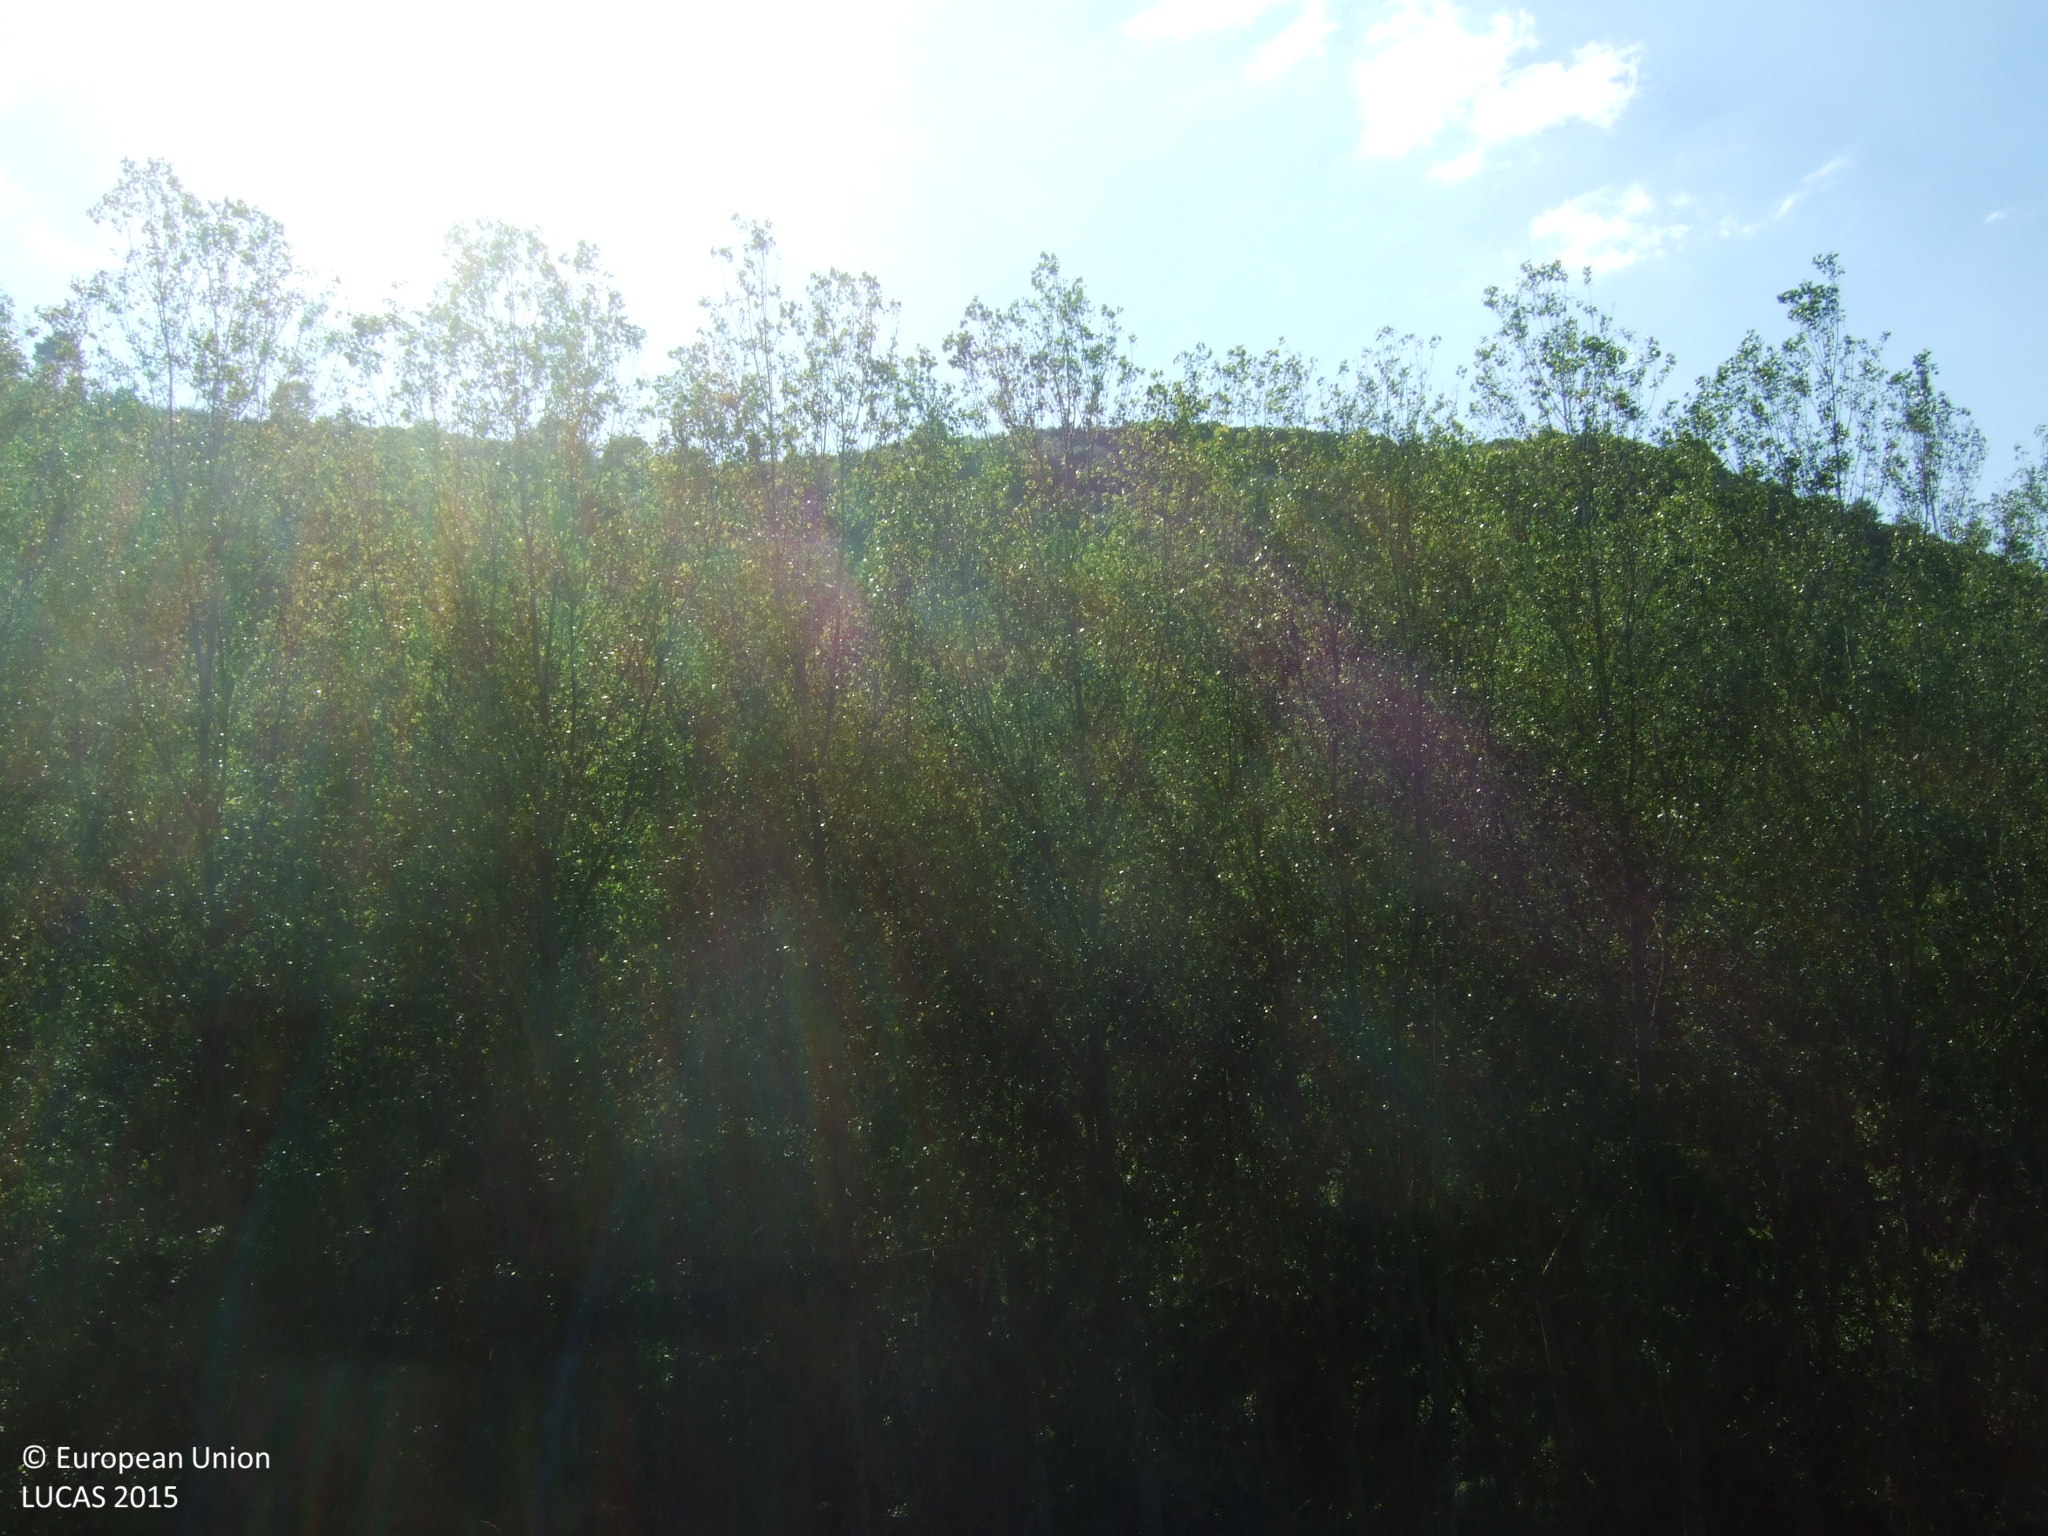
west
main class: Grassland
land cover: Grassland without tree/shrub cover
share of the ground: > 75 %
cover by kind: herbaceous plants 100 %
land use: Agriculture (excluding fallow land and kitchen gardens)
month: June
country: ES
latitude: 42.7719
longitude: -6.9859
